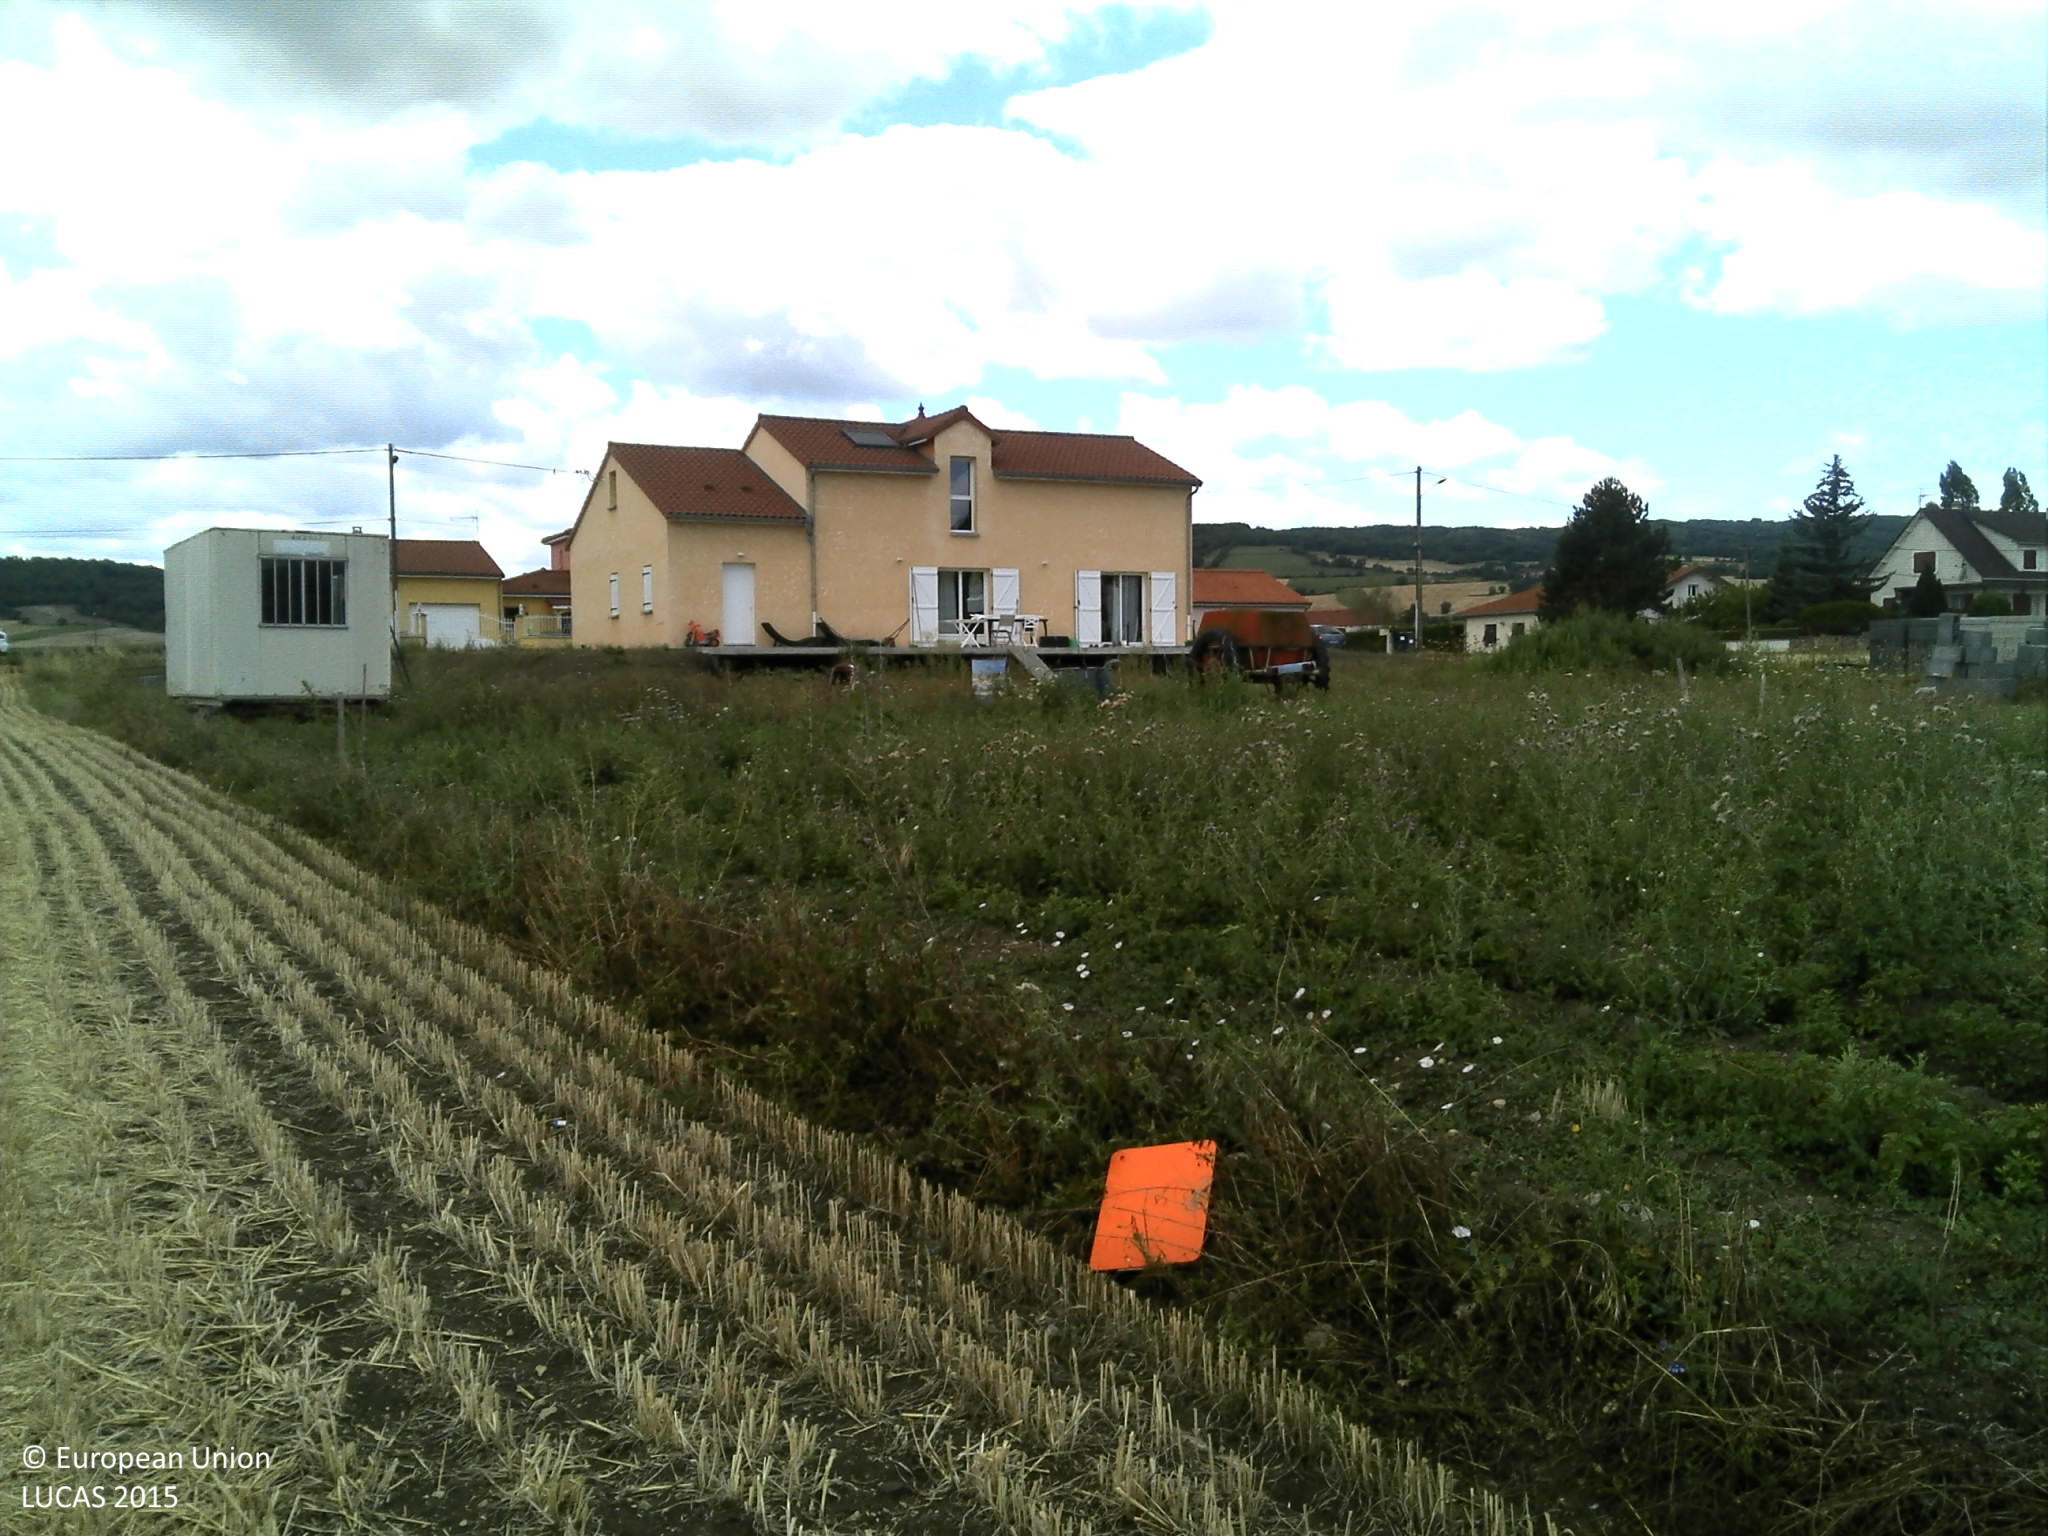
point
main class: Cropland
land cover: Potatoes
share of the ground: < 10 %
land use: Kitchen garden
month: July
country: FR
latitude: 45.5007
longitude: 3.1797
